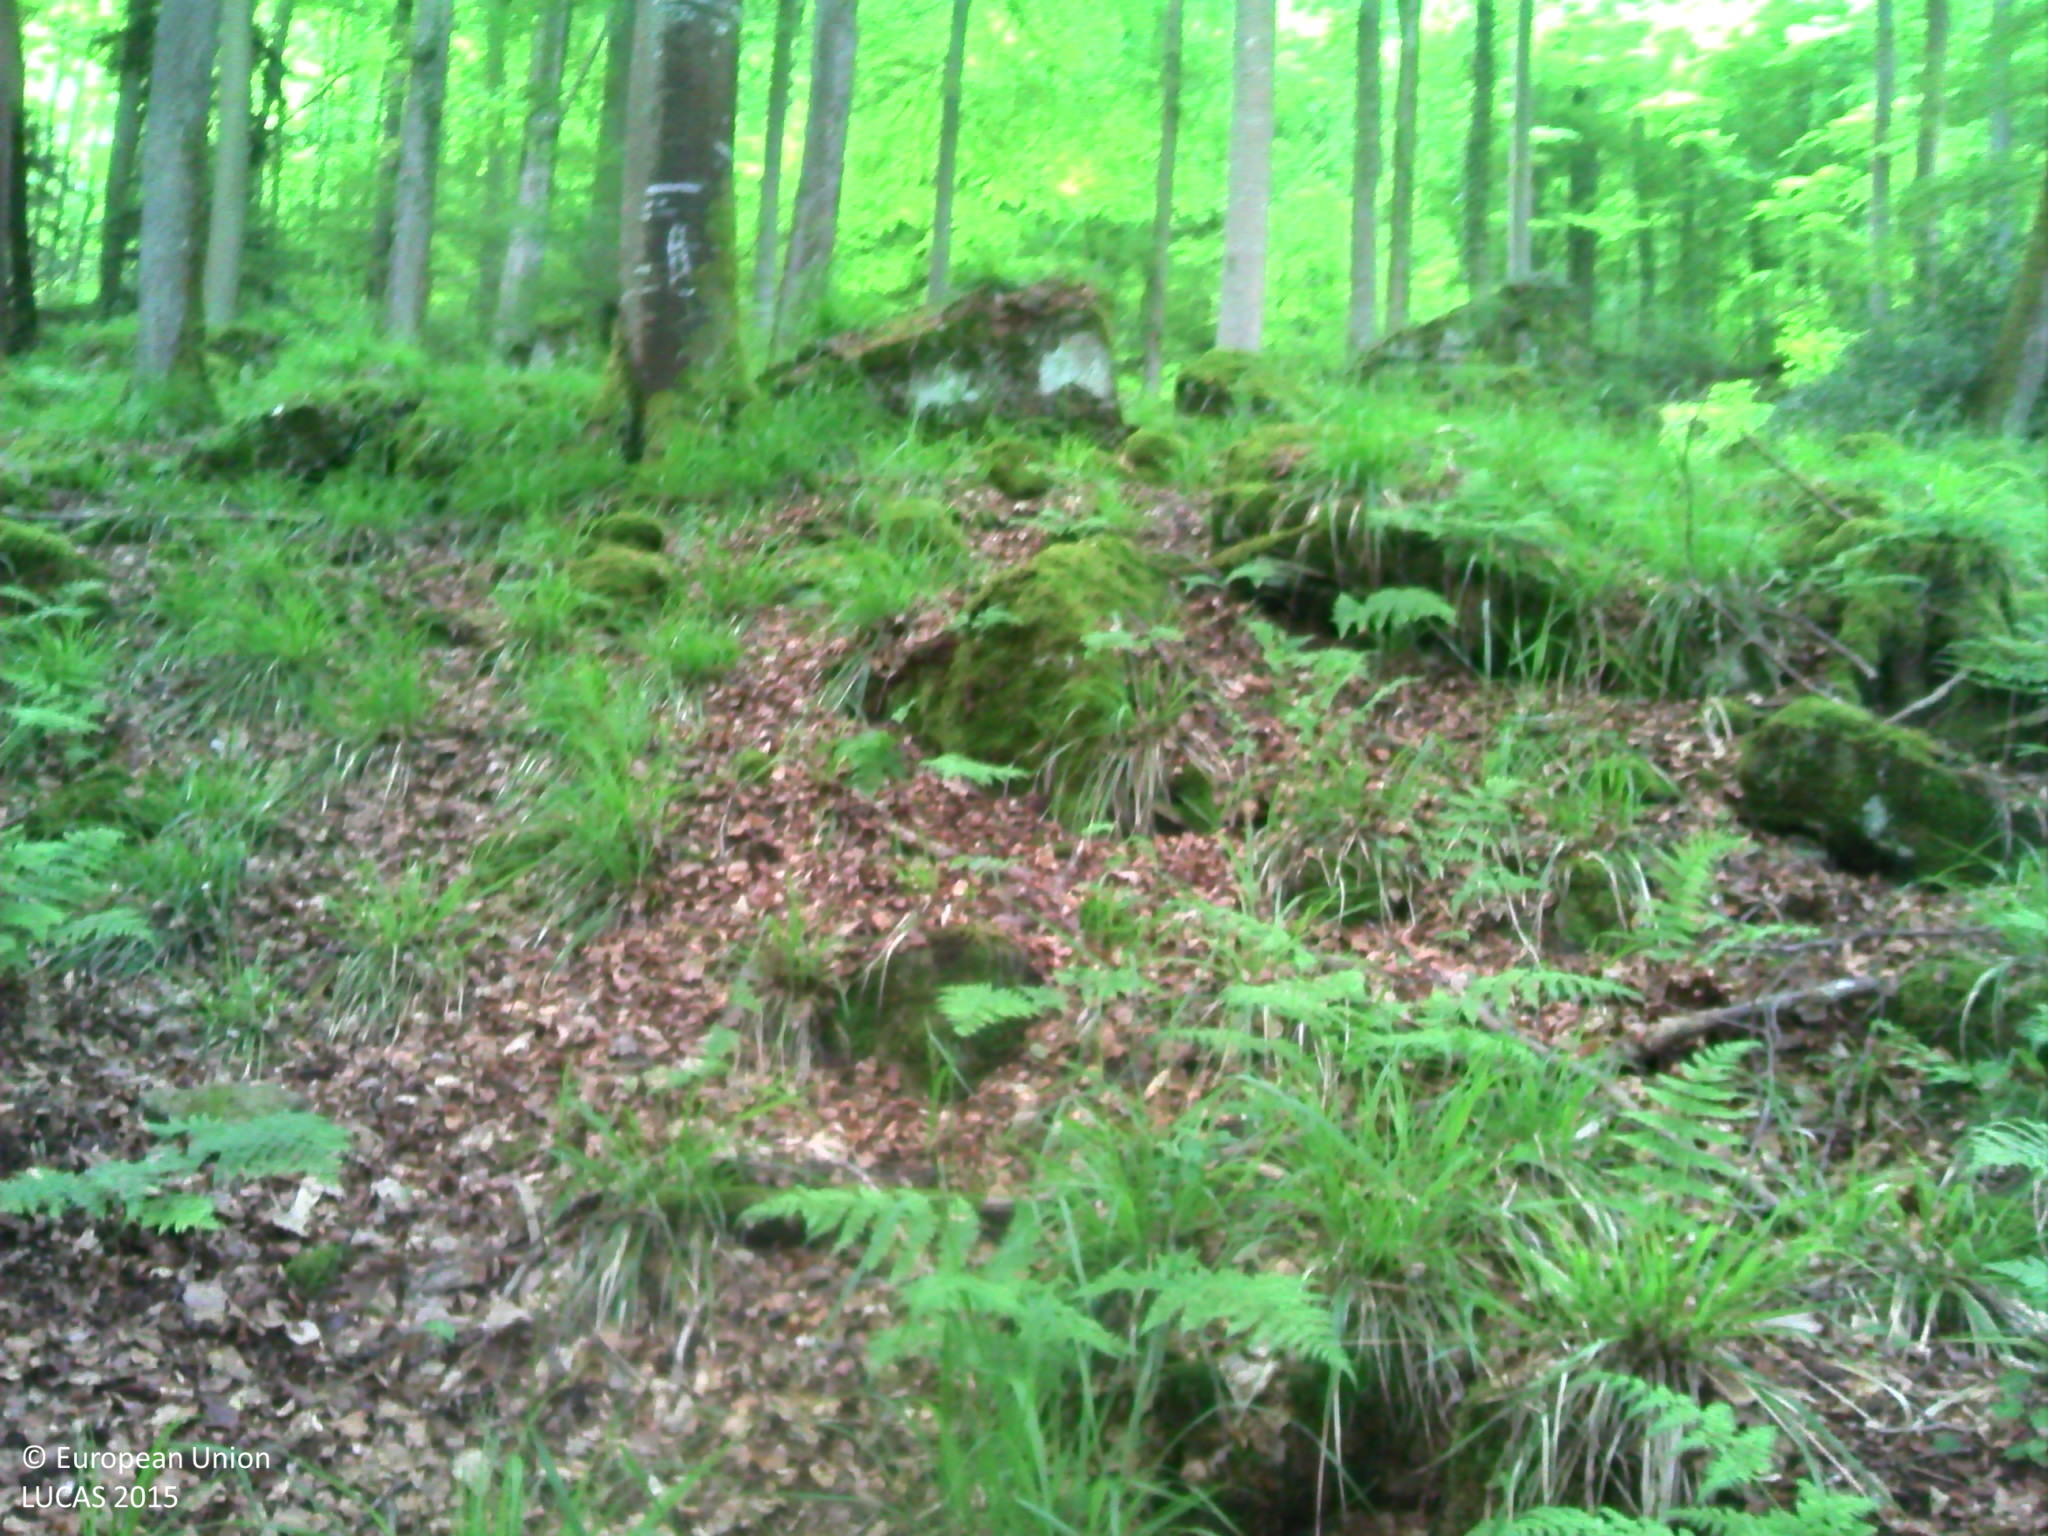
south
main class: Woodland
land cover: Broadleaved woodland
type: acidophilous oak and oak-birch forest
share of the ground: > 75 %
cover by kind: broadleaved forest trees 75 %, herbaceous plants 20 %, lichens and mosses 5 %
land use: Forestry
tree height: > 5 m
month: May
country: LU
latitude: 49.8385
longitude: 6.3706
